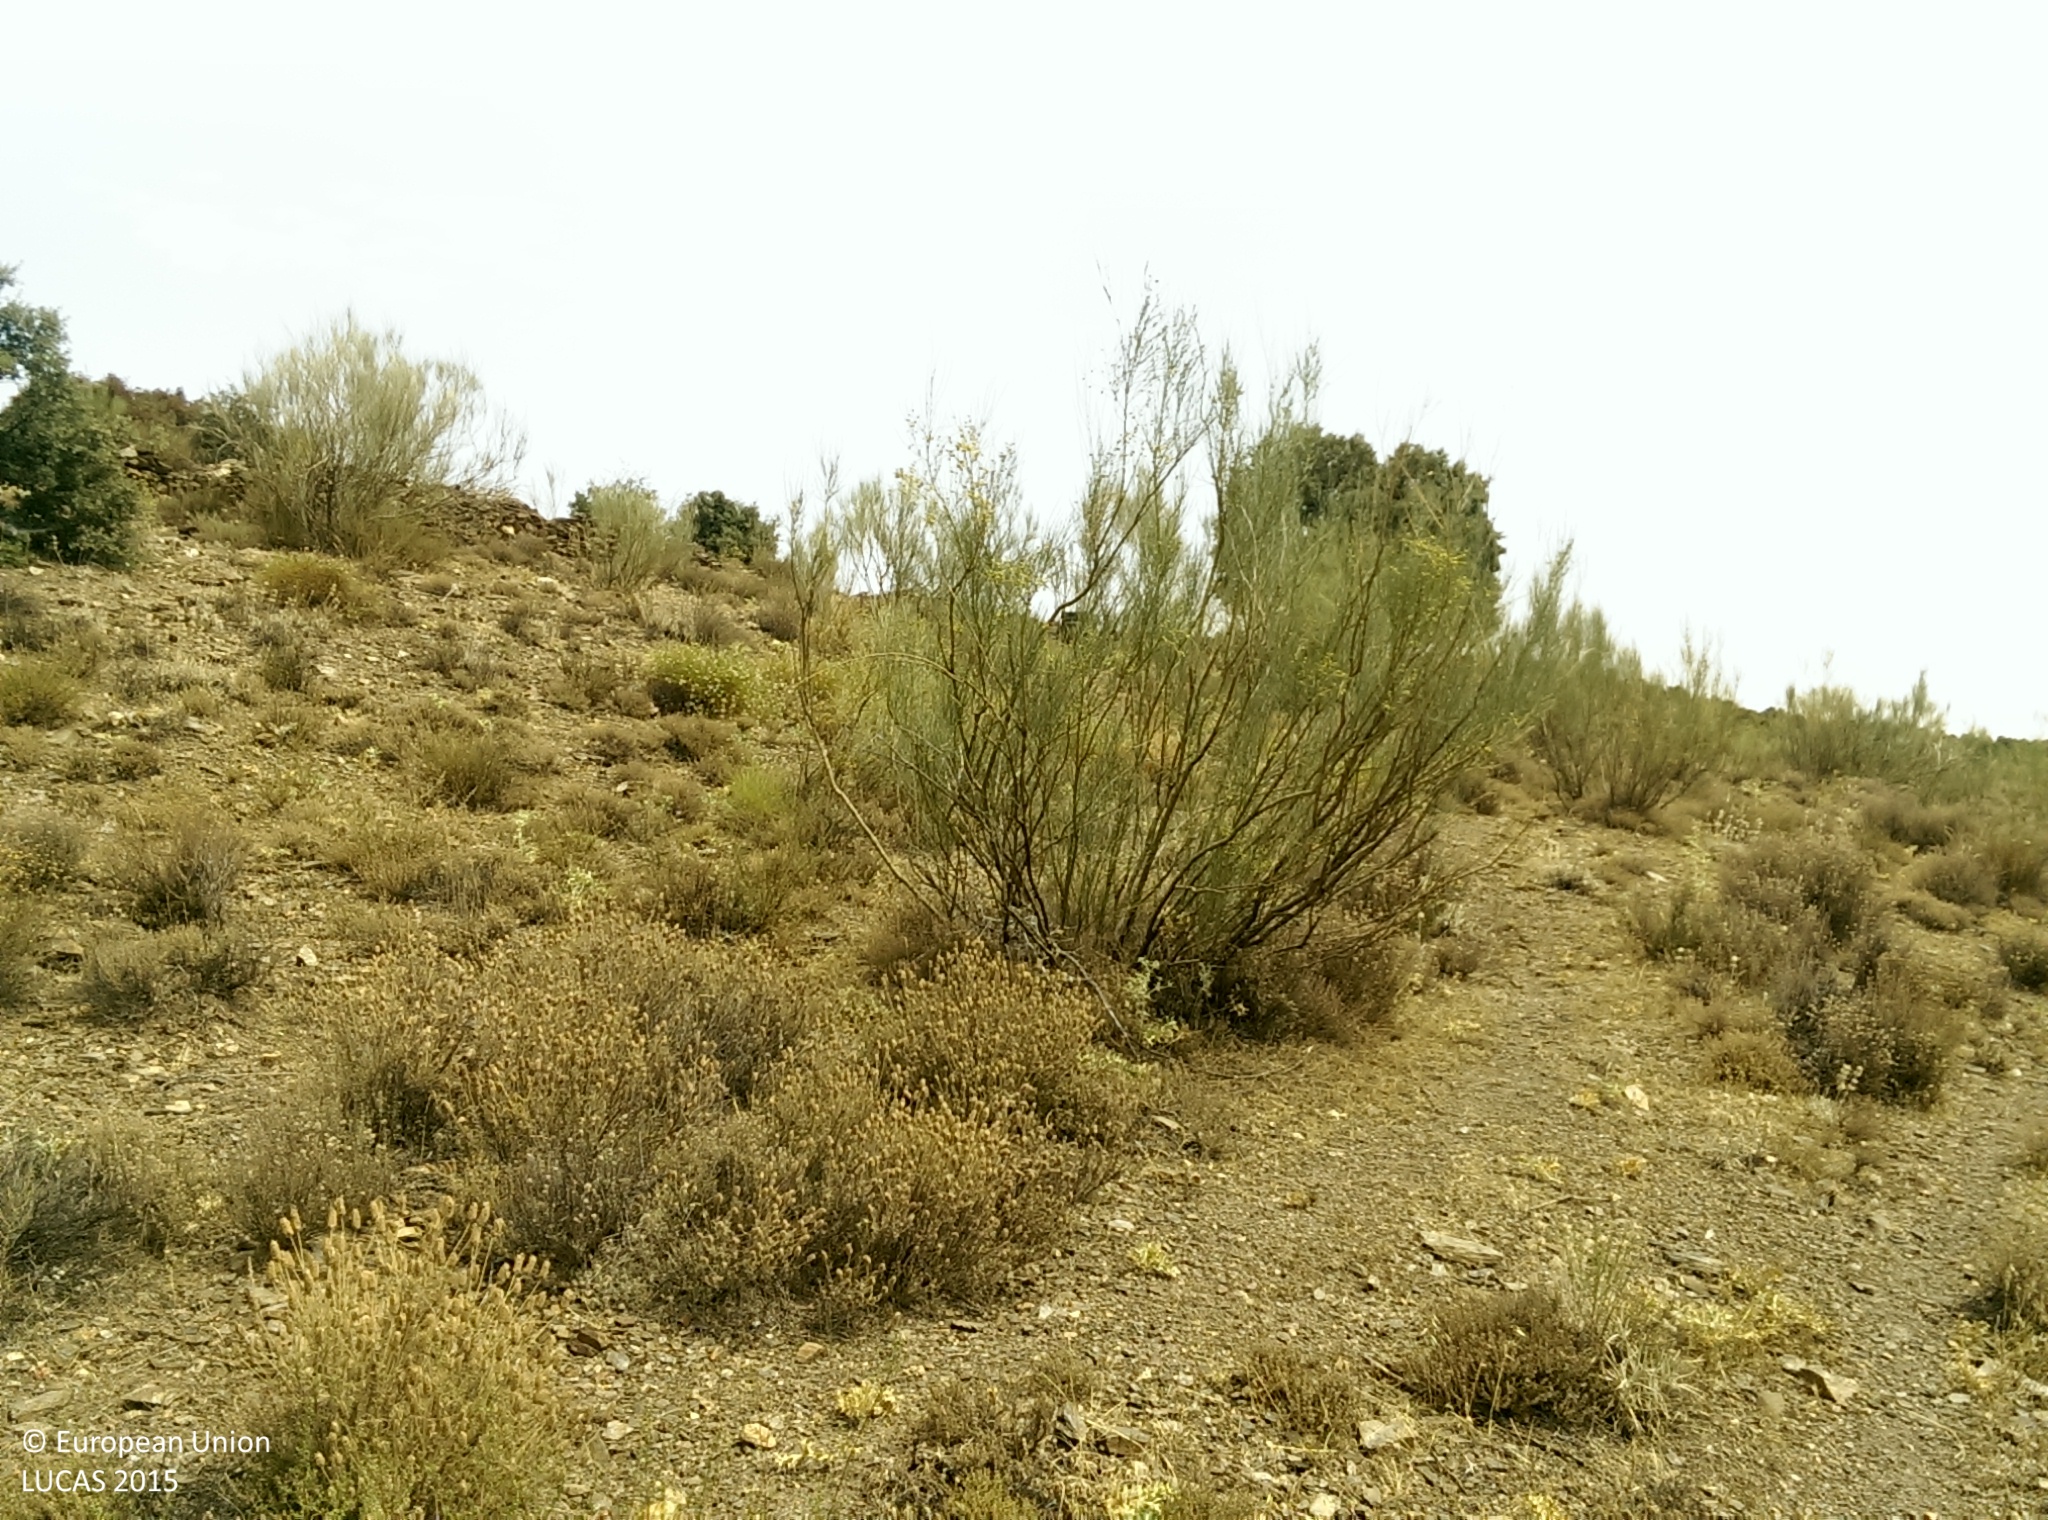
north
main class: Shrubland
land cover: Shrubland without tree cover
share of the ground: 50 - 75 %
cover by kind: shrubs 50 %, herbaceous plants 30 %, unconsolidated bare surface 20 %
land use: Semi-natural and natural areas not in use
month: July
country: ES
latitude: 37.1753
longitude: -3.1743
